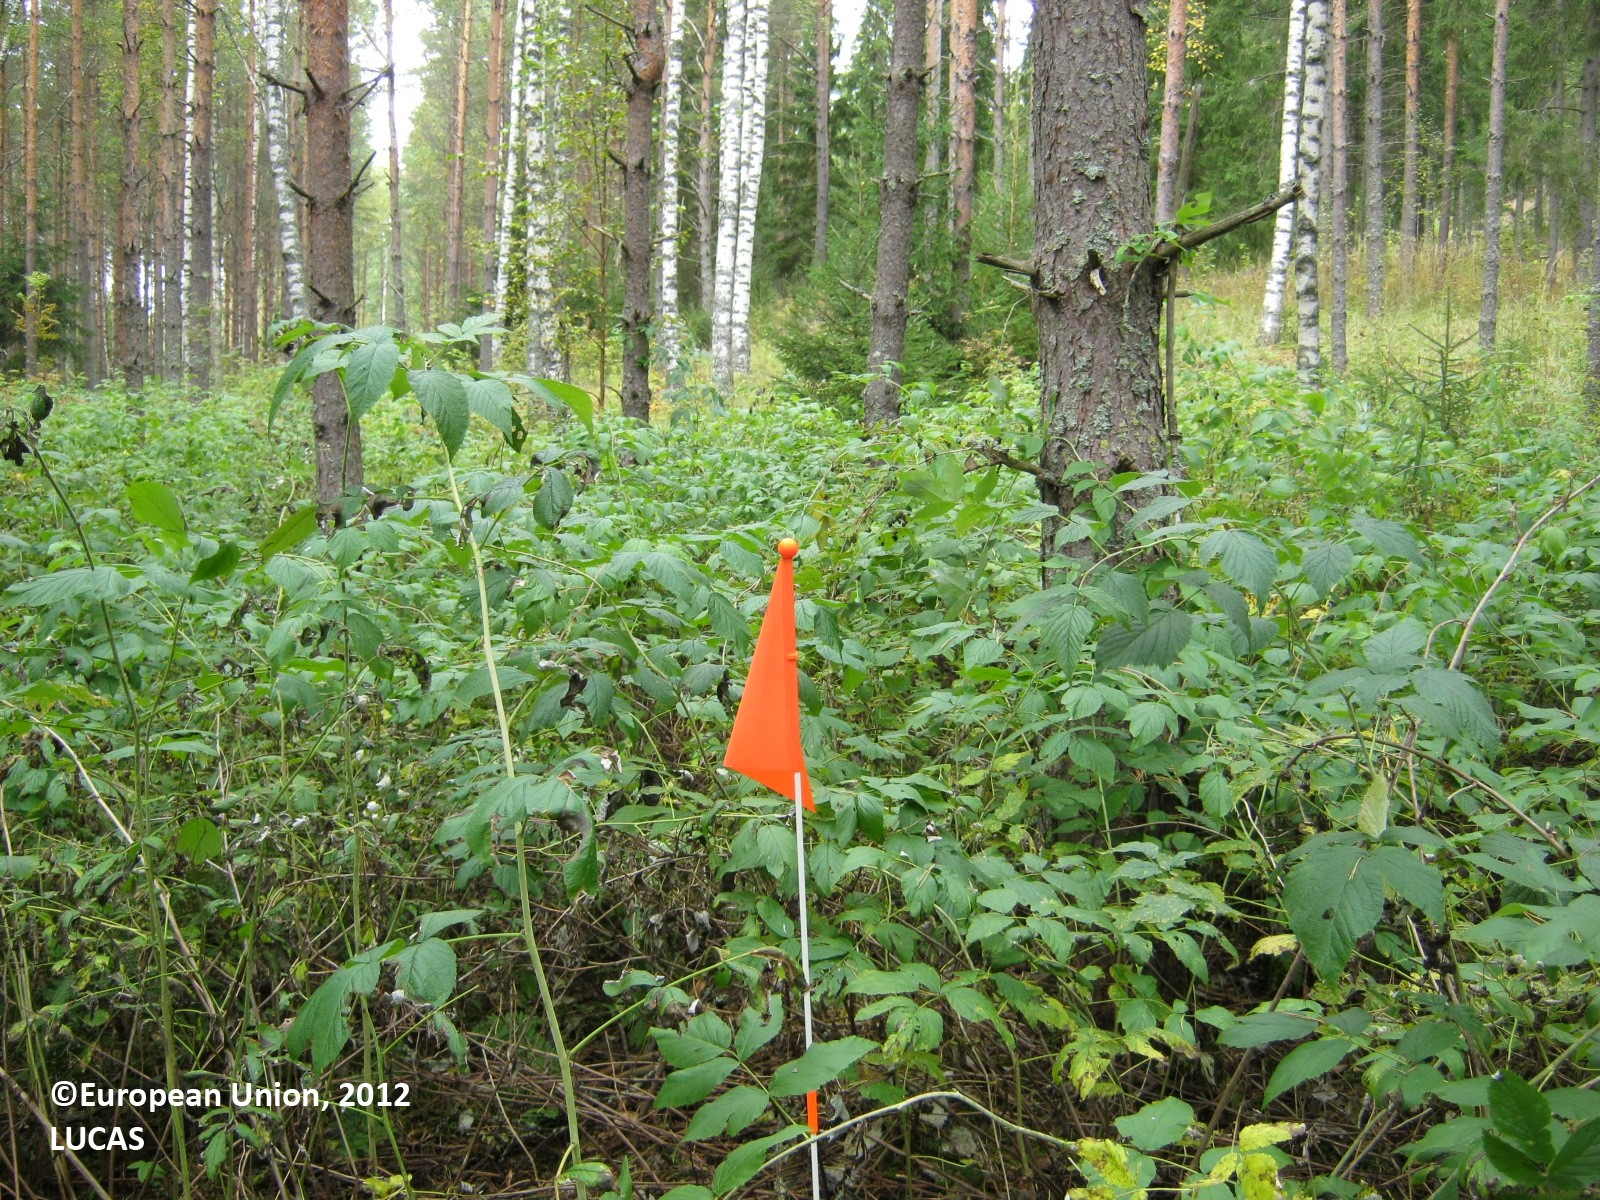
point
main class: Woodland
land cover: Spruce dominated mixed woodland
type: boreal forest
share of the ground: > 75 %
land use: Forestry
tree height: > 5 m
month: September
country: FI
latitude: 60.6845
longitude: 27.7902
